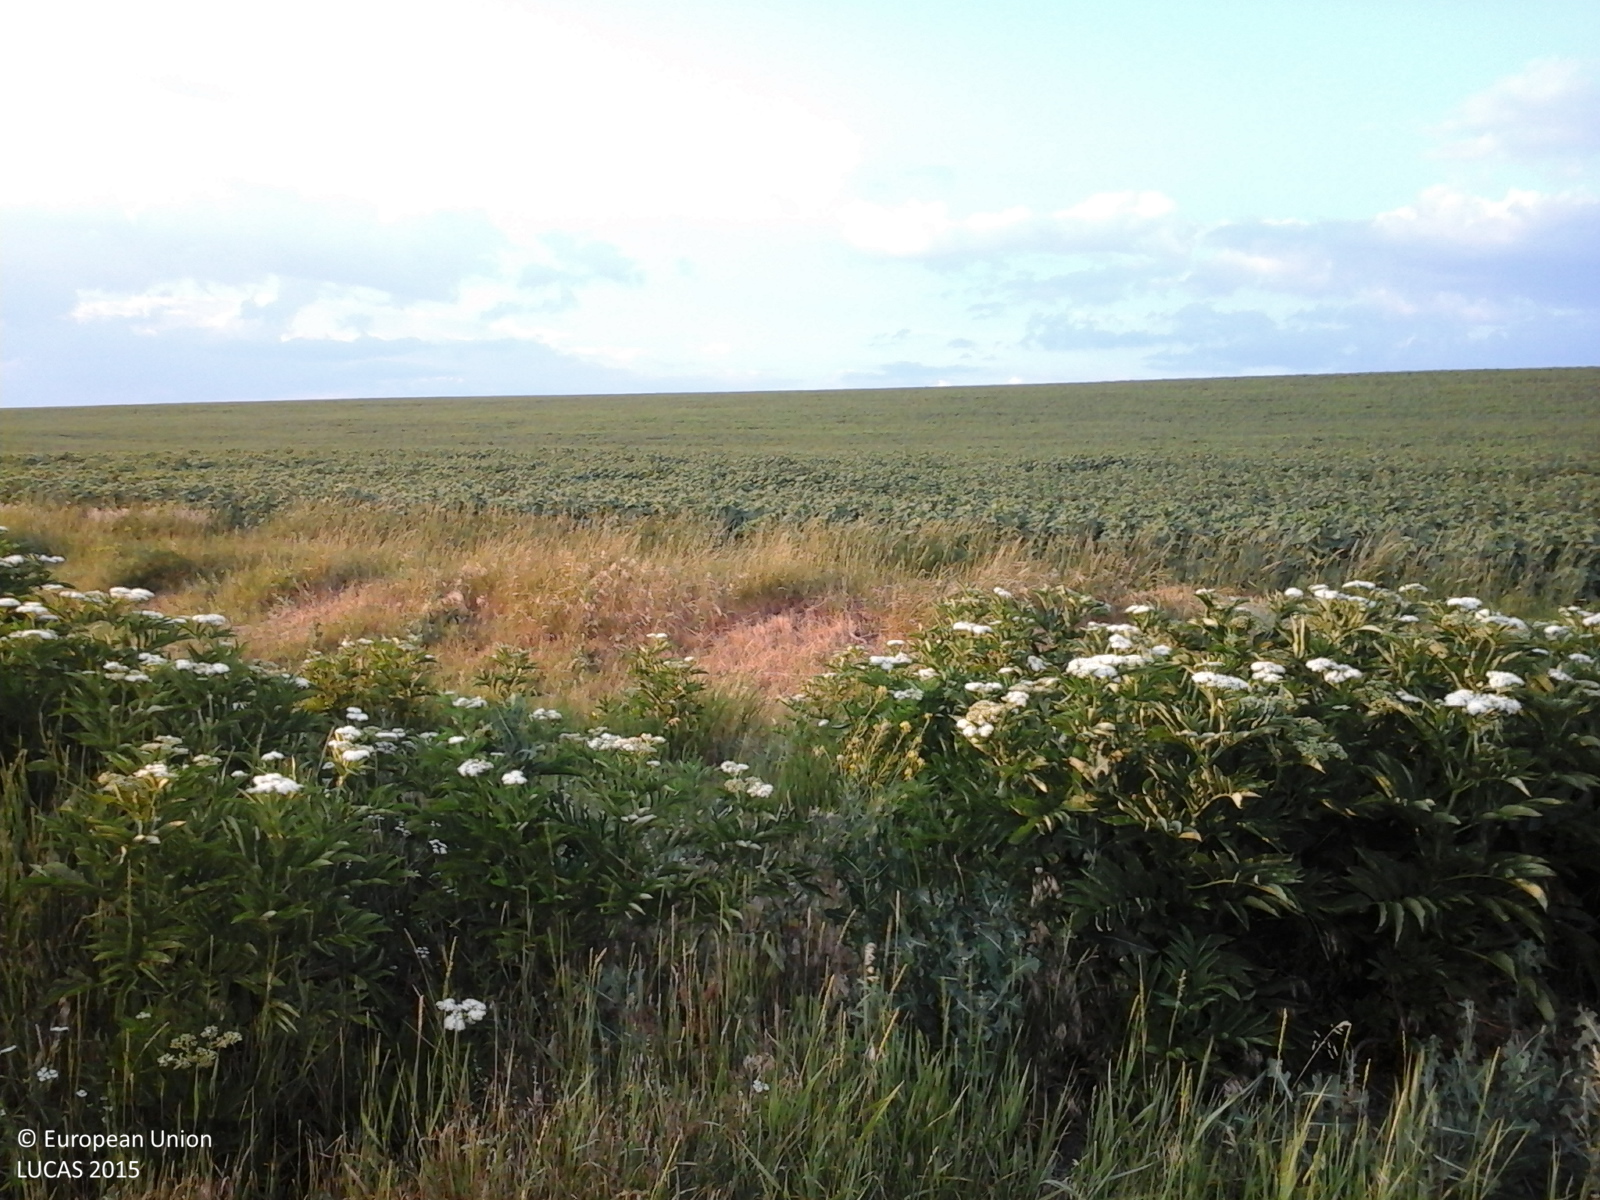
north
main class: Grassland
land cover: Spontaneously vegetated surfaces
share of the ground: > 75 %
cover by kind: herbaceous plants 100 %
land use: Fallow land
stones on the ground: < 10 %
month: June
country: RO
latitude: 46.7489
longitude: 28.0774
